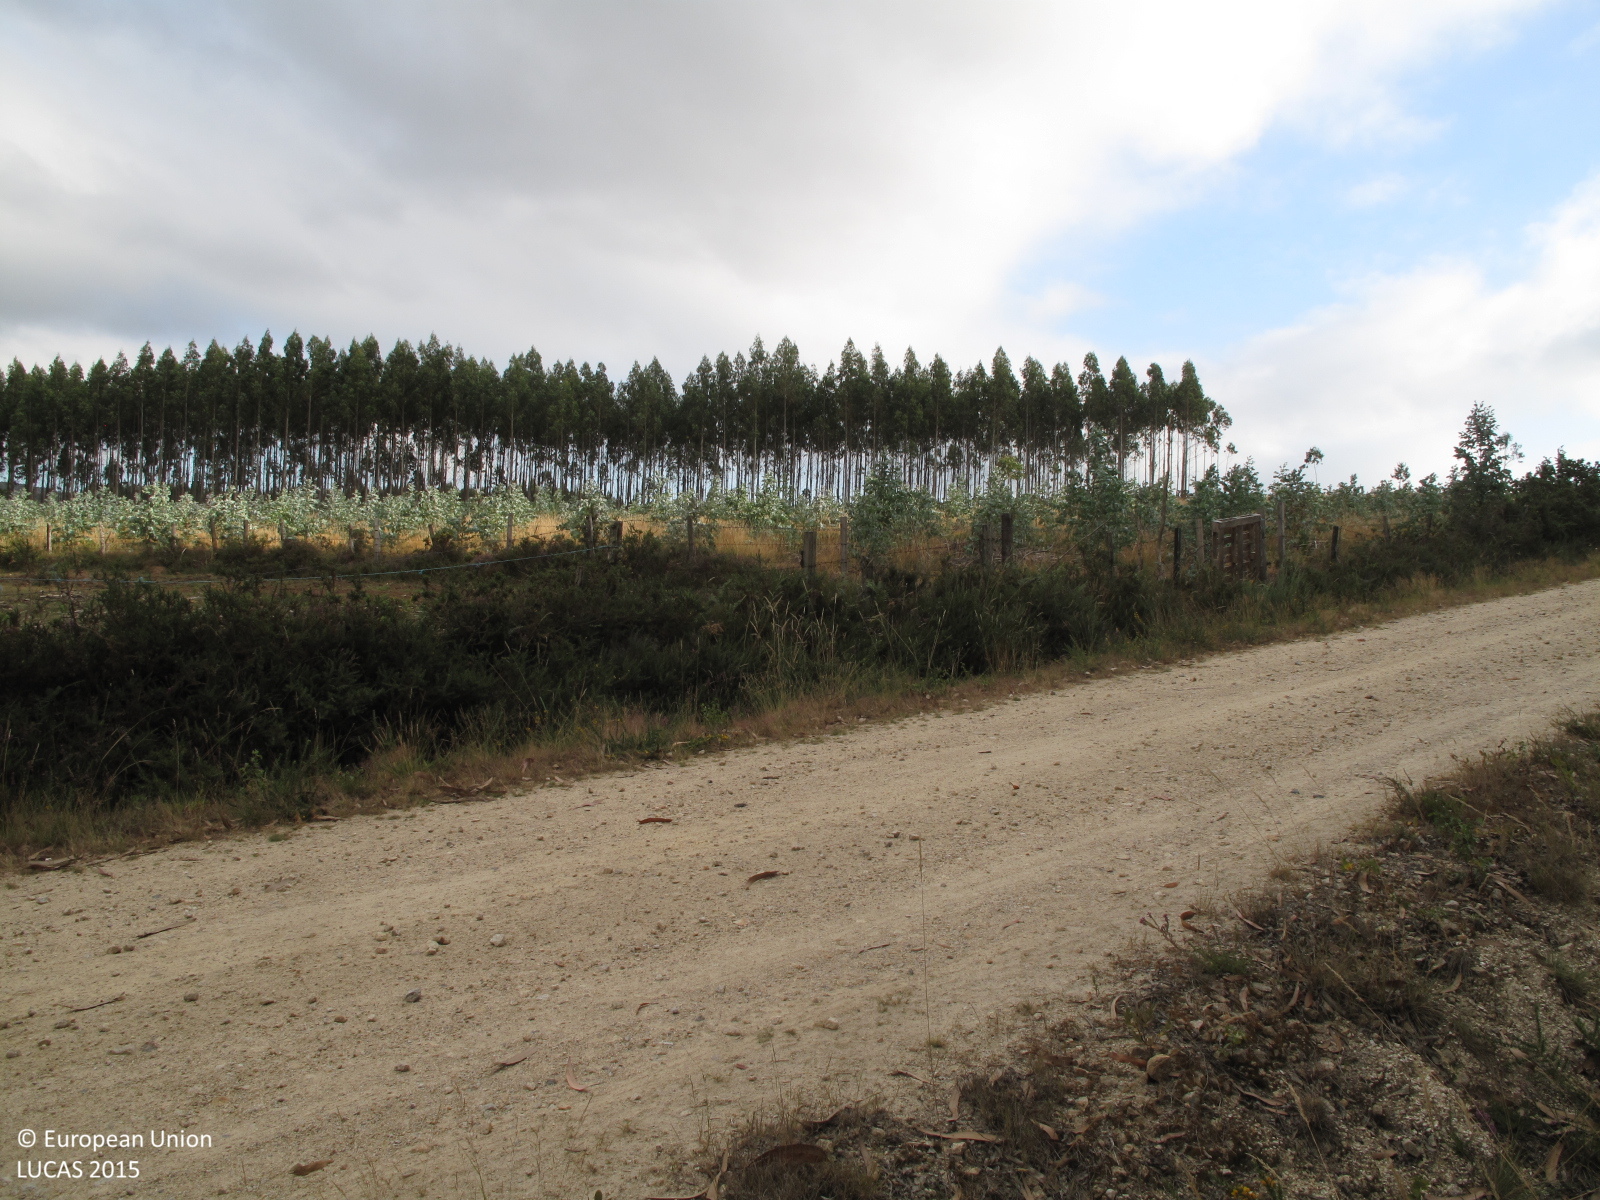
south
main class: Woodland
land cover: Broadleaved woodland
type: exotic forest
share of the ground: 50 - 75 %
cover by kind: broadleaved forest trees 70 %, shrubs 20 %, herbaceous plants 10 %
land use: Forestry
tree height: > 5 m
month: July
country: ES
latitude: 43.1028
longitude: -7.9428
